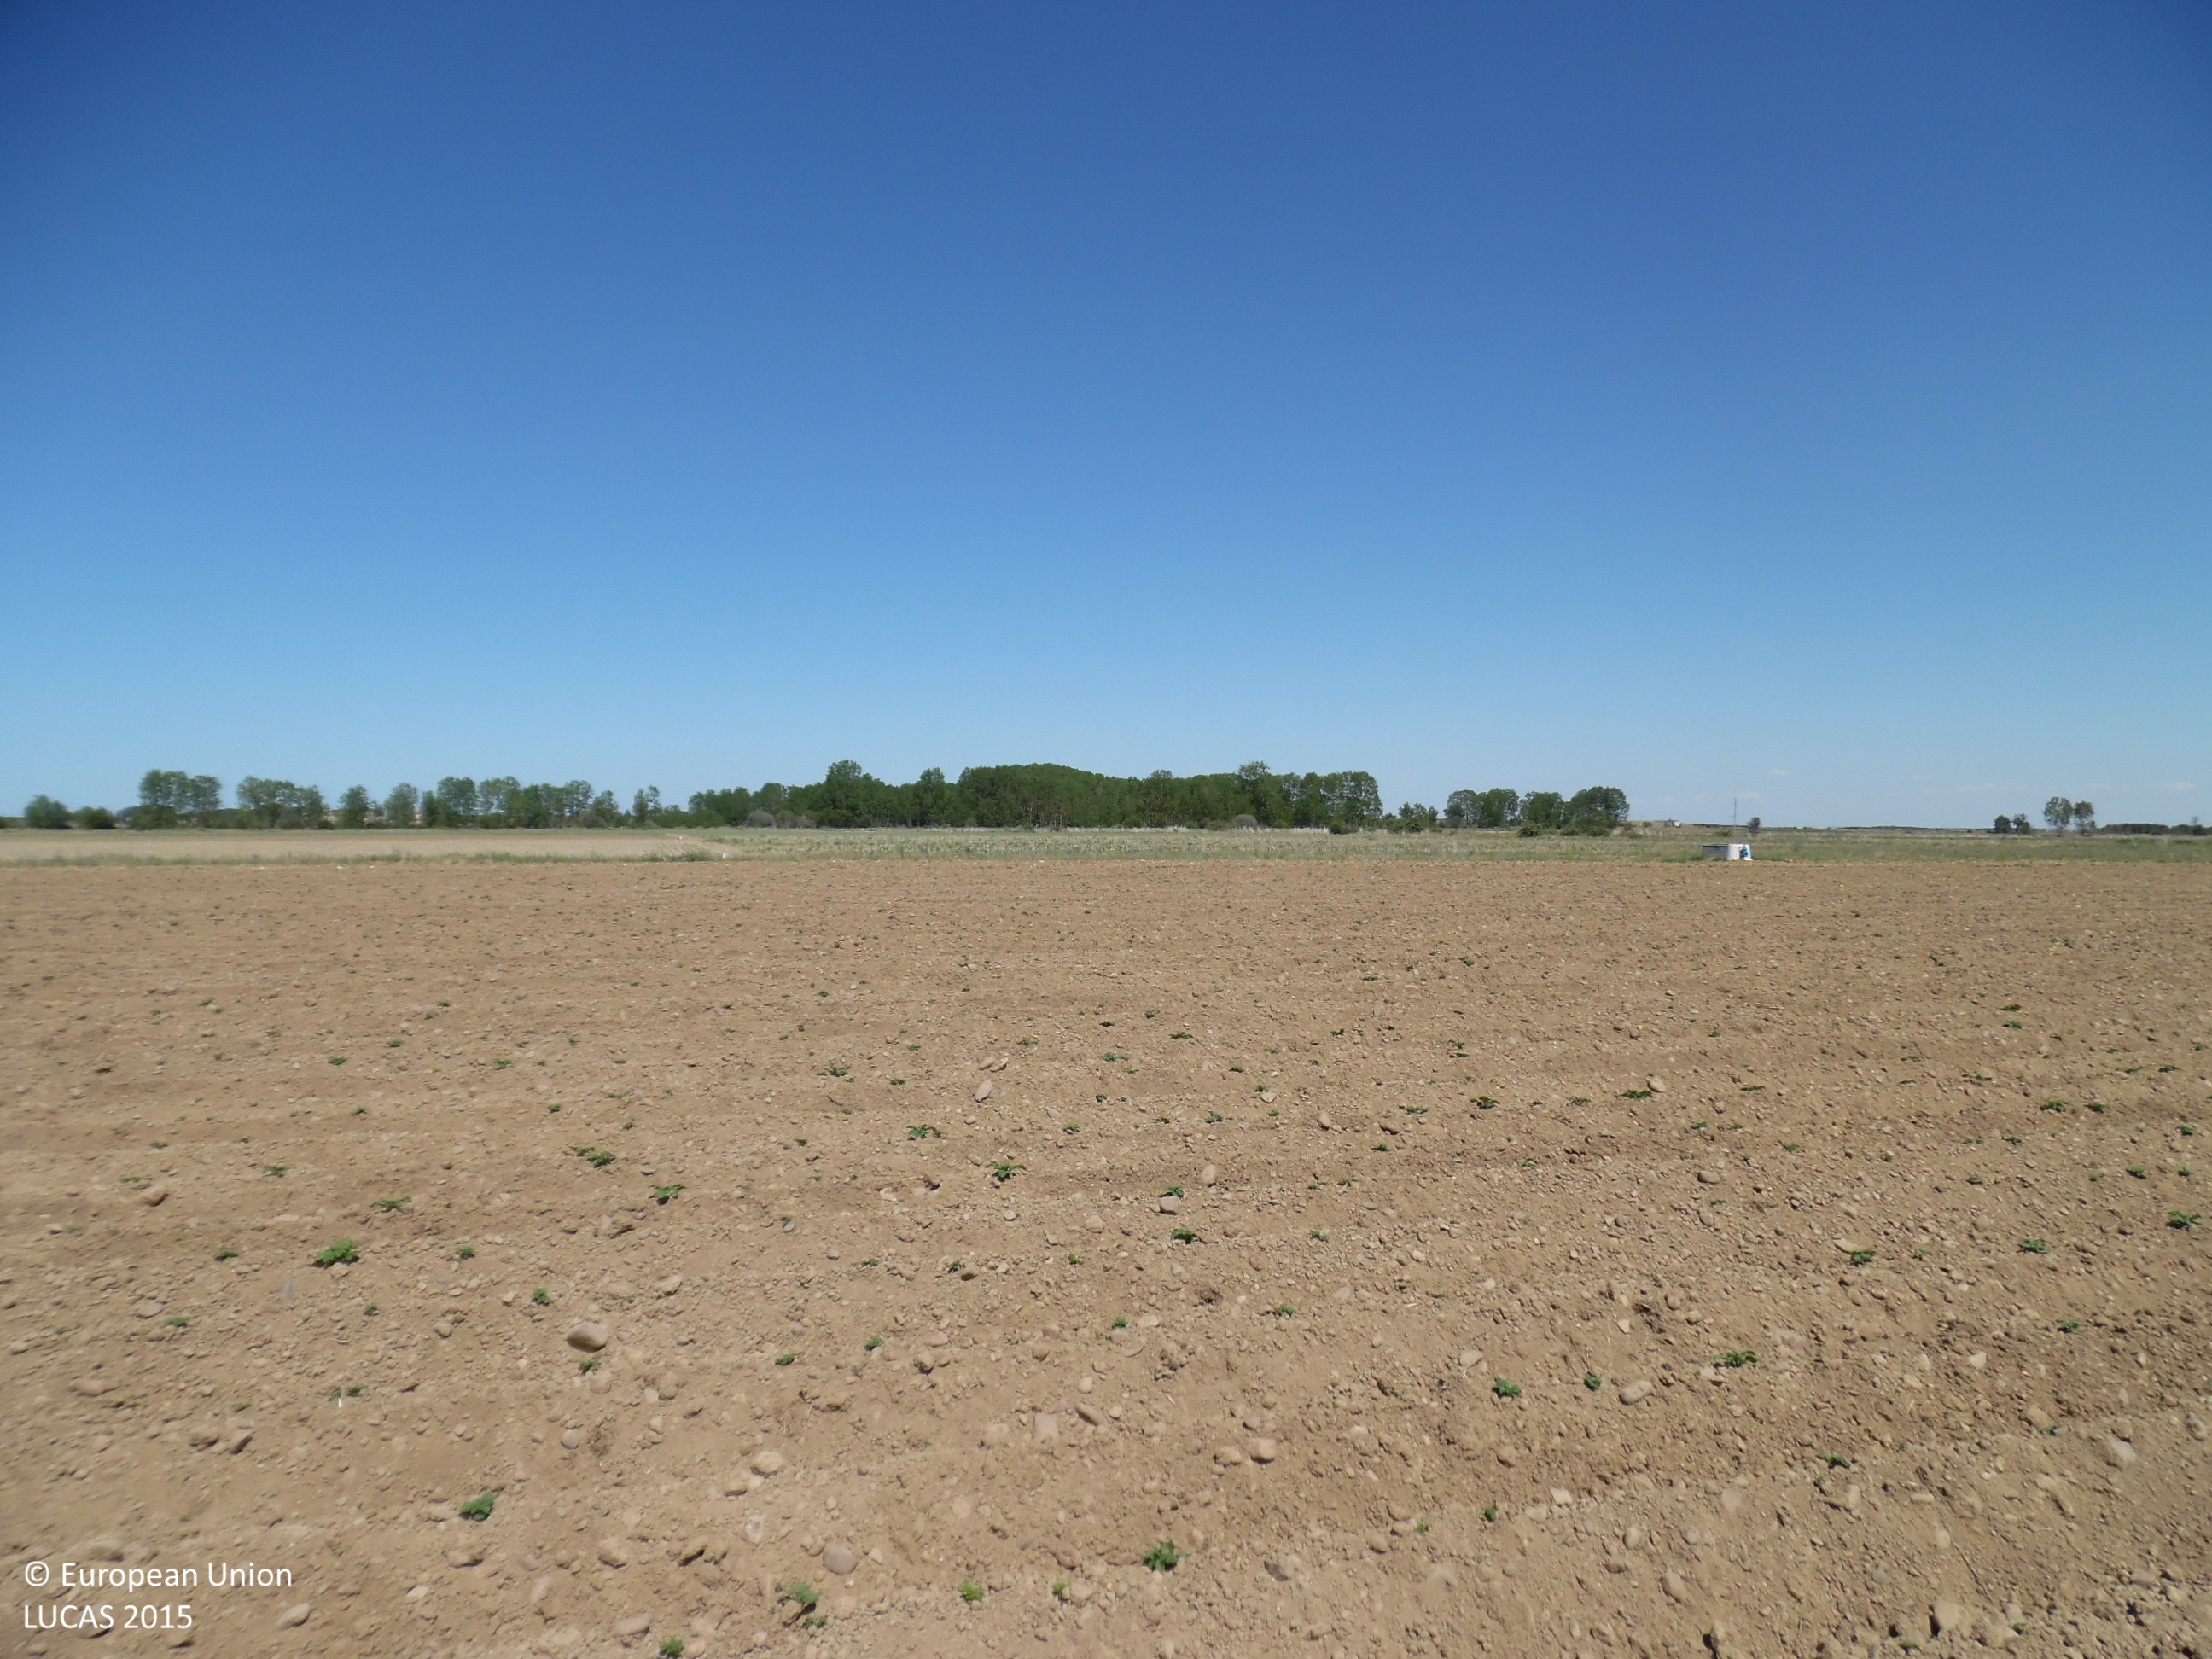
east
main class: Cropland
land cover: Potatoes
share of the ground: < 10 %
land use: Agriculture (excluding fallow land and kitchen gardens)
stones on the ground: 10 - 25 %
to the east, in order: Potatoes; Spontaneously vegetated surfaces
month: June
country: ES
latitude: 42.4280
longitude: -5.7168
